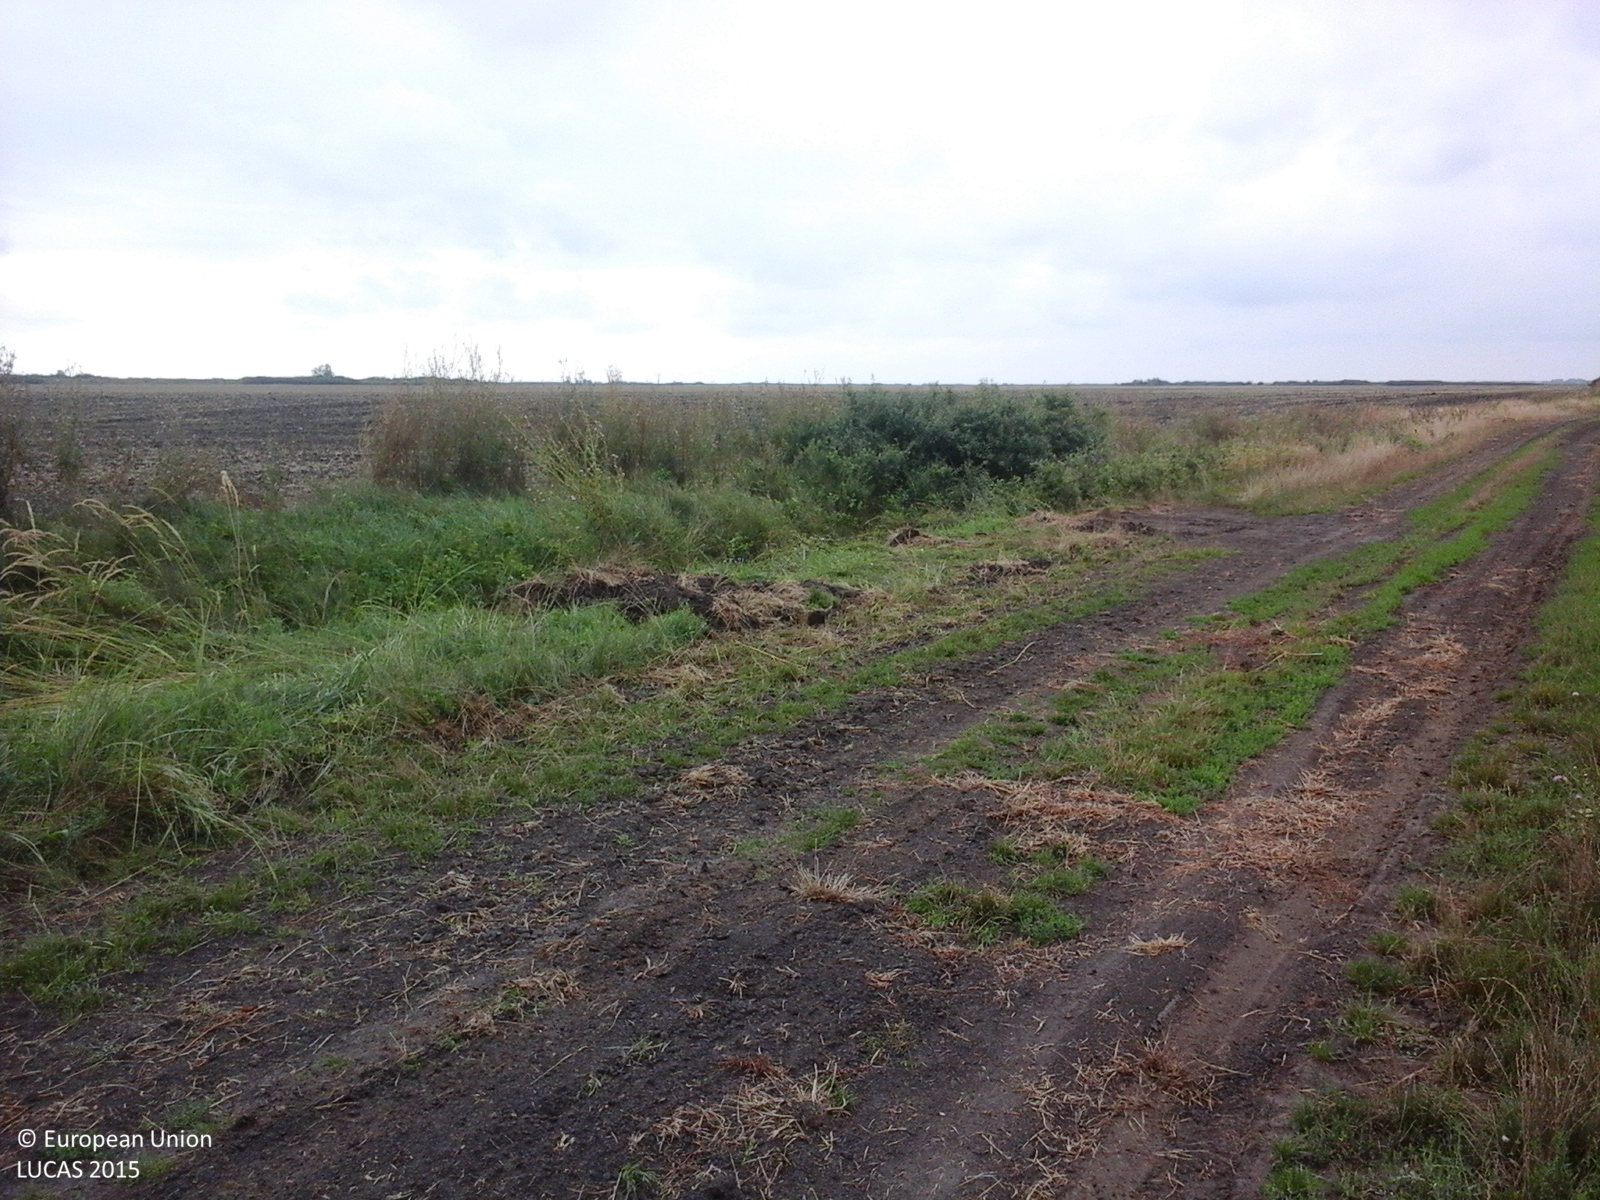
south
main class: Cropland
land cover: Sunflower
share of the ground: > 75 %
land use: Agriculture (excluding fallow land and kitchen gardens)
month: August
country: RO
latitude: 46.0859
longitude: 20.5129
